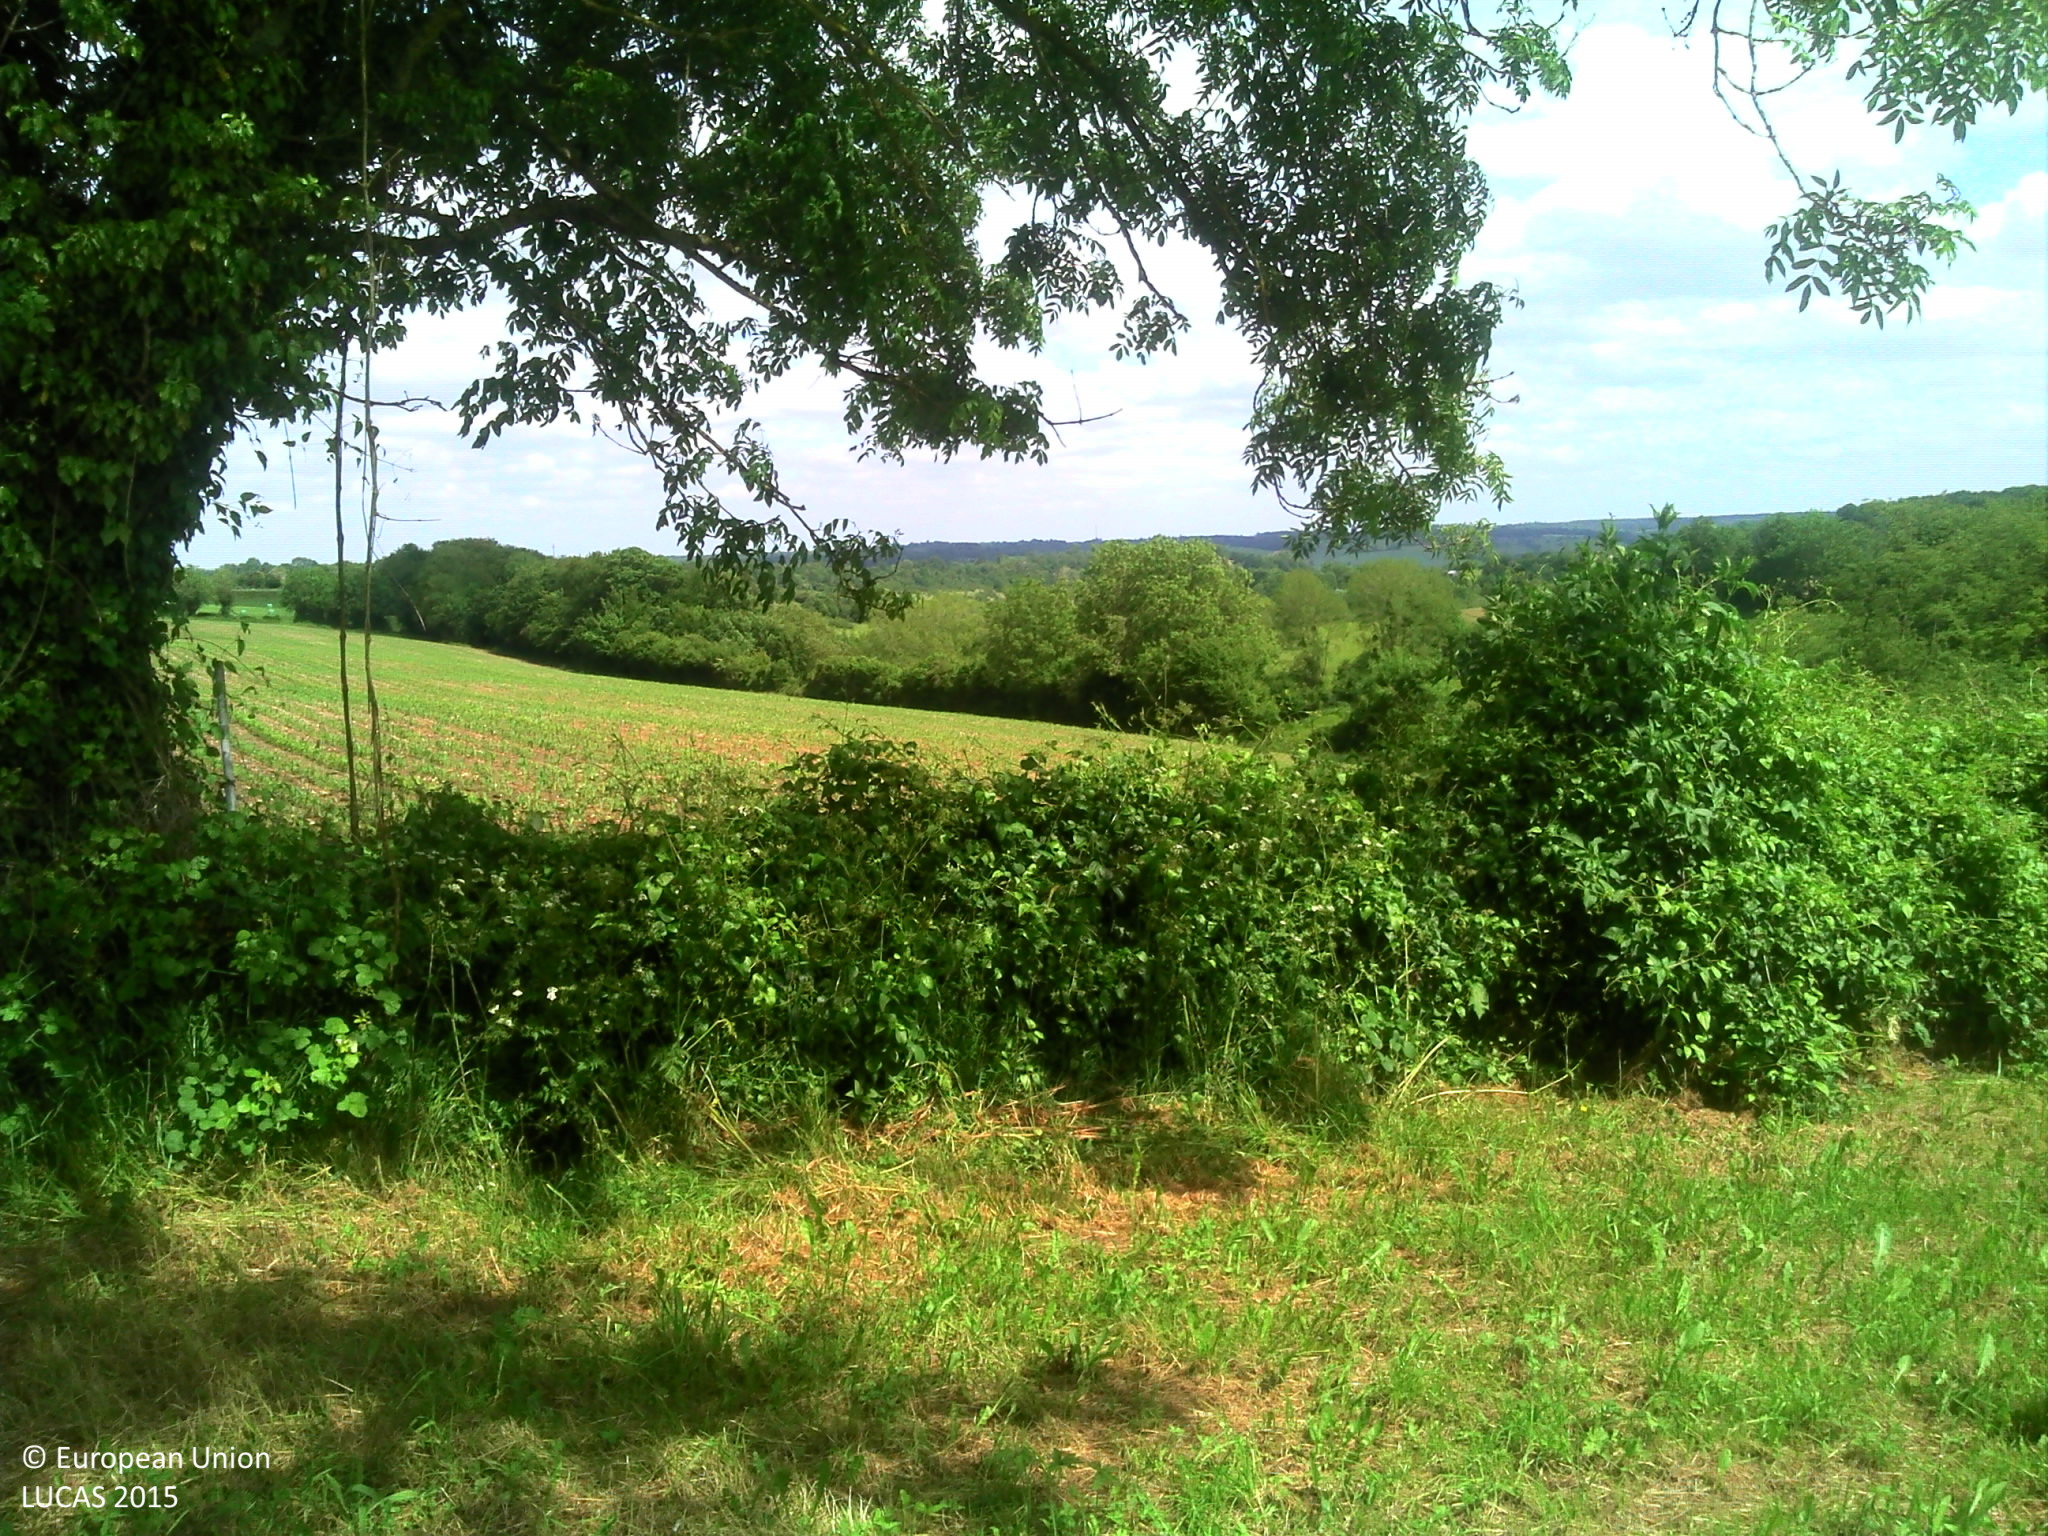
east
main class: Cropland
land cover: Apple fruit
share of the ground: > 75 %
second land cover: Spontaneously vegetated surfaces
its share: > 75 %
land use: Agriculture (excluding fallow land and kitchen gardens)
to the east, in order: Apple fruit; Spontaneously vegetated surfaces; Fences; Single bushes/trees; Managed hedges; Grass margins; Maize; Managed hedges
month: June
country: FR
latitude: 48.9239
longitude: 0.1581
